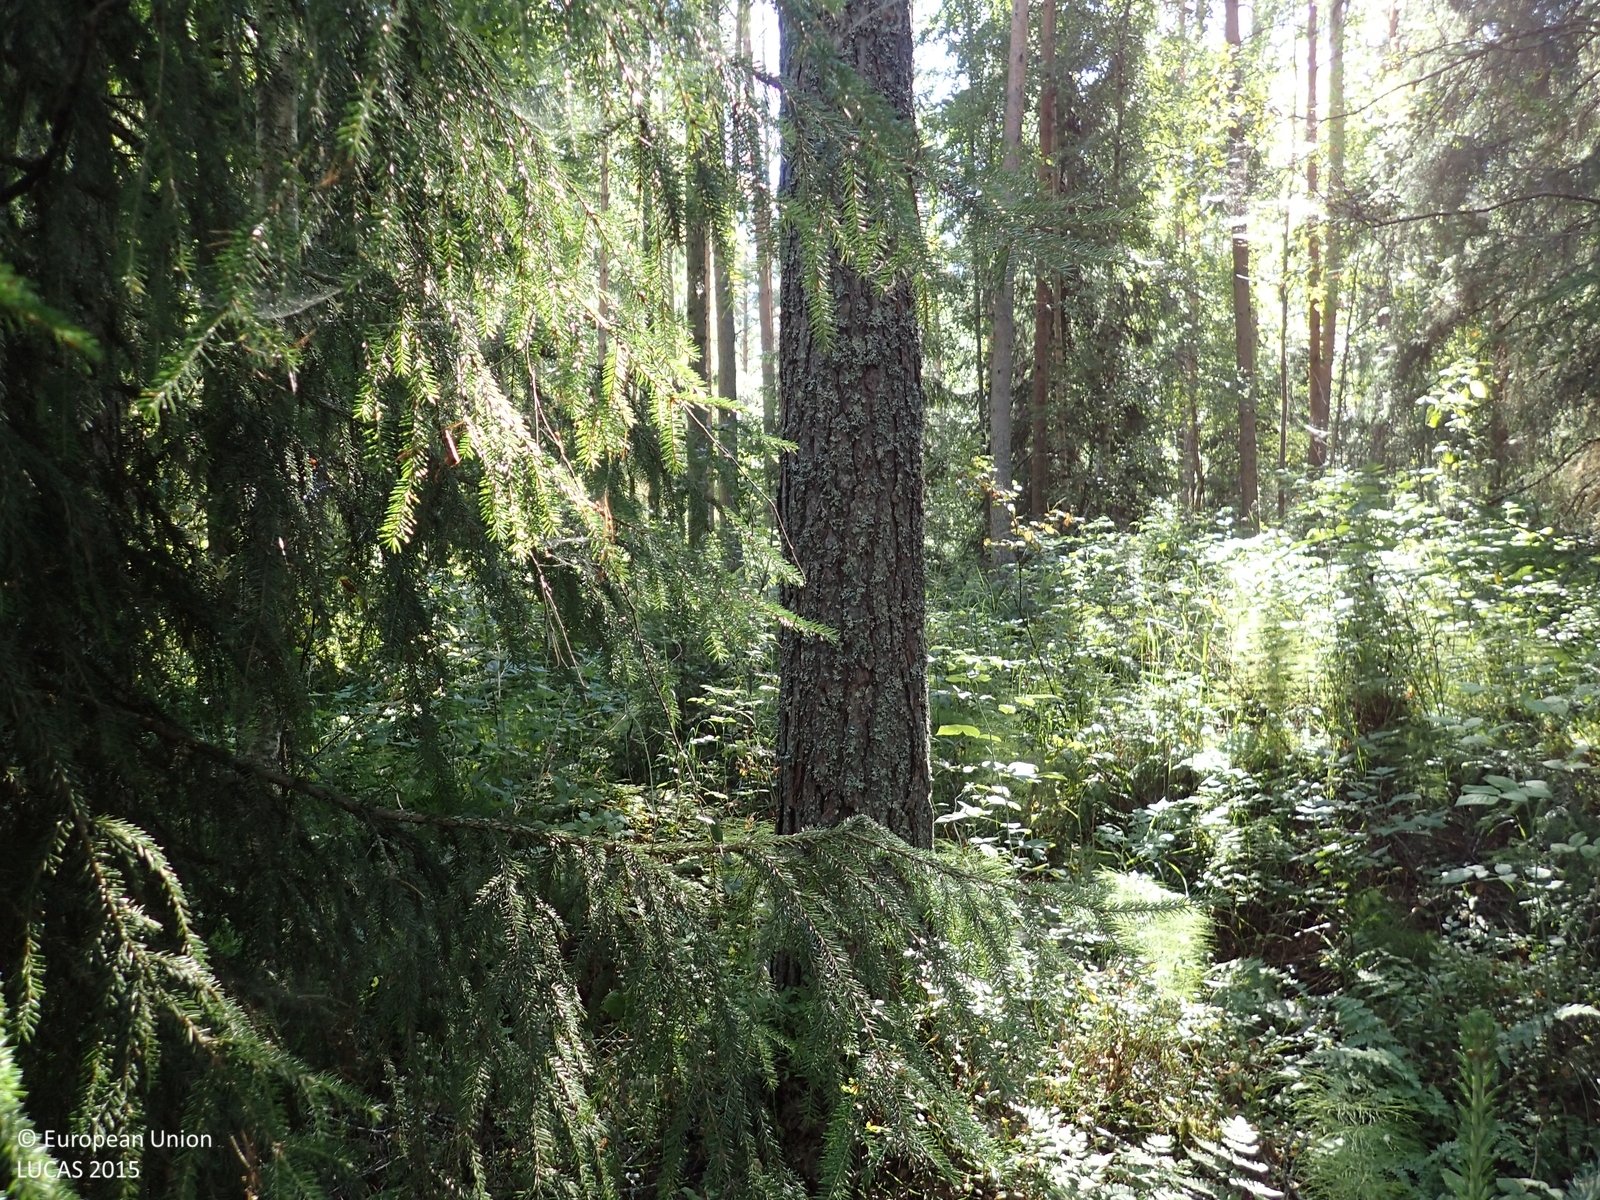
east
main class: Woodland
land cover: Other mixed woodland
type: boreal forest
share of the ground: > 75 %
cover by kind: coniferous forest trees 55 %, broadleaved forest trees 20 %, shrubs 10 %, herbaceous plants 10 %, lichens and mosses 5 %
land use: Forestry
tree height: > 5 m
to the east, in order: Other mixed woodland; Ditches and canals; Pine dominated mixed woodland; Ditches and canals; Pine dominated mixed woodland; Ditches and canals; Pine dominated mixed woodland; Ditches and canals; Pine dominated mixed woodland; Other mixed woodland; Pine dominated coniferous woodland
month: August
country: FI
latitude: 62.6367
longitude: 22.5165
